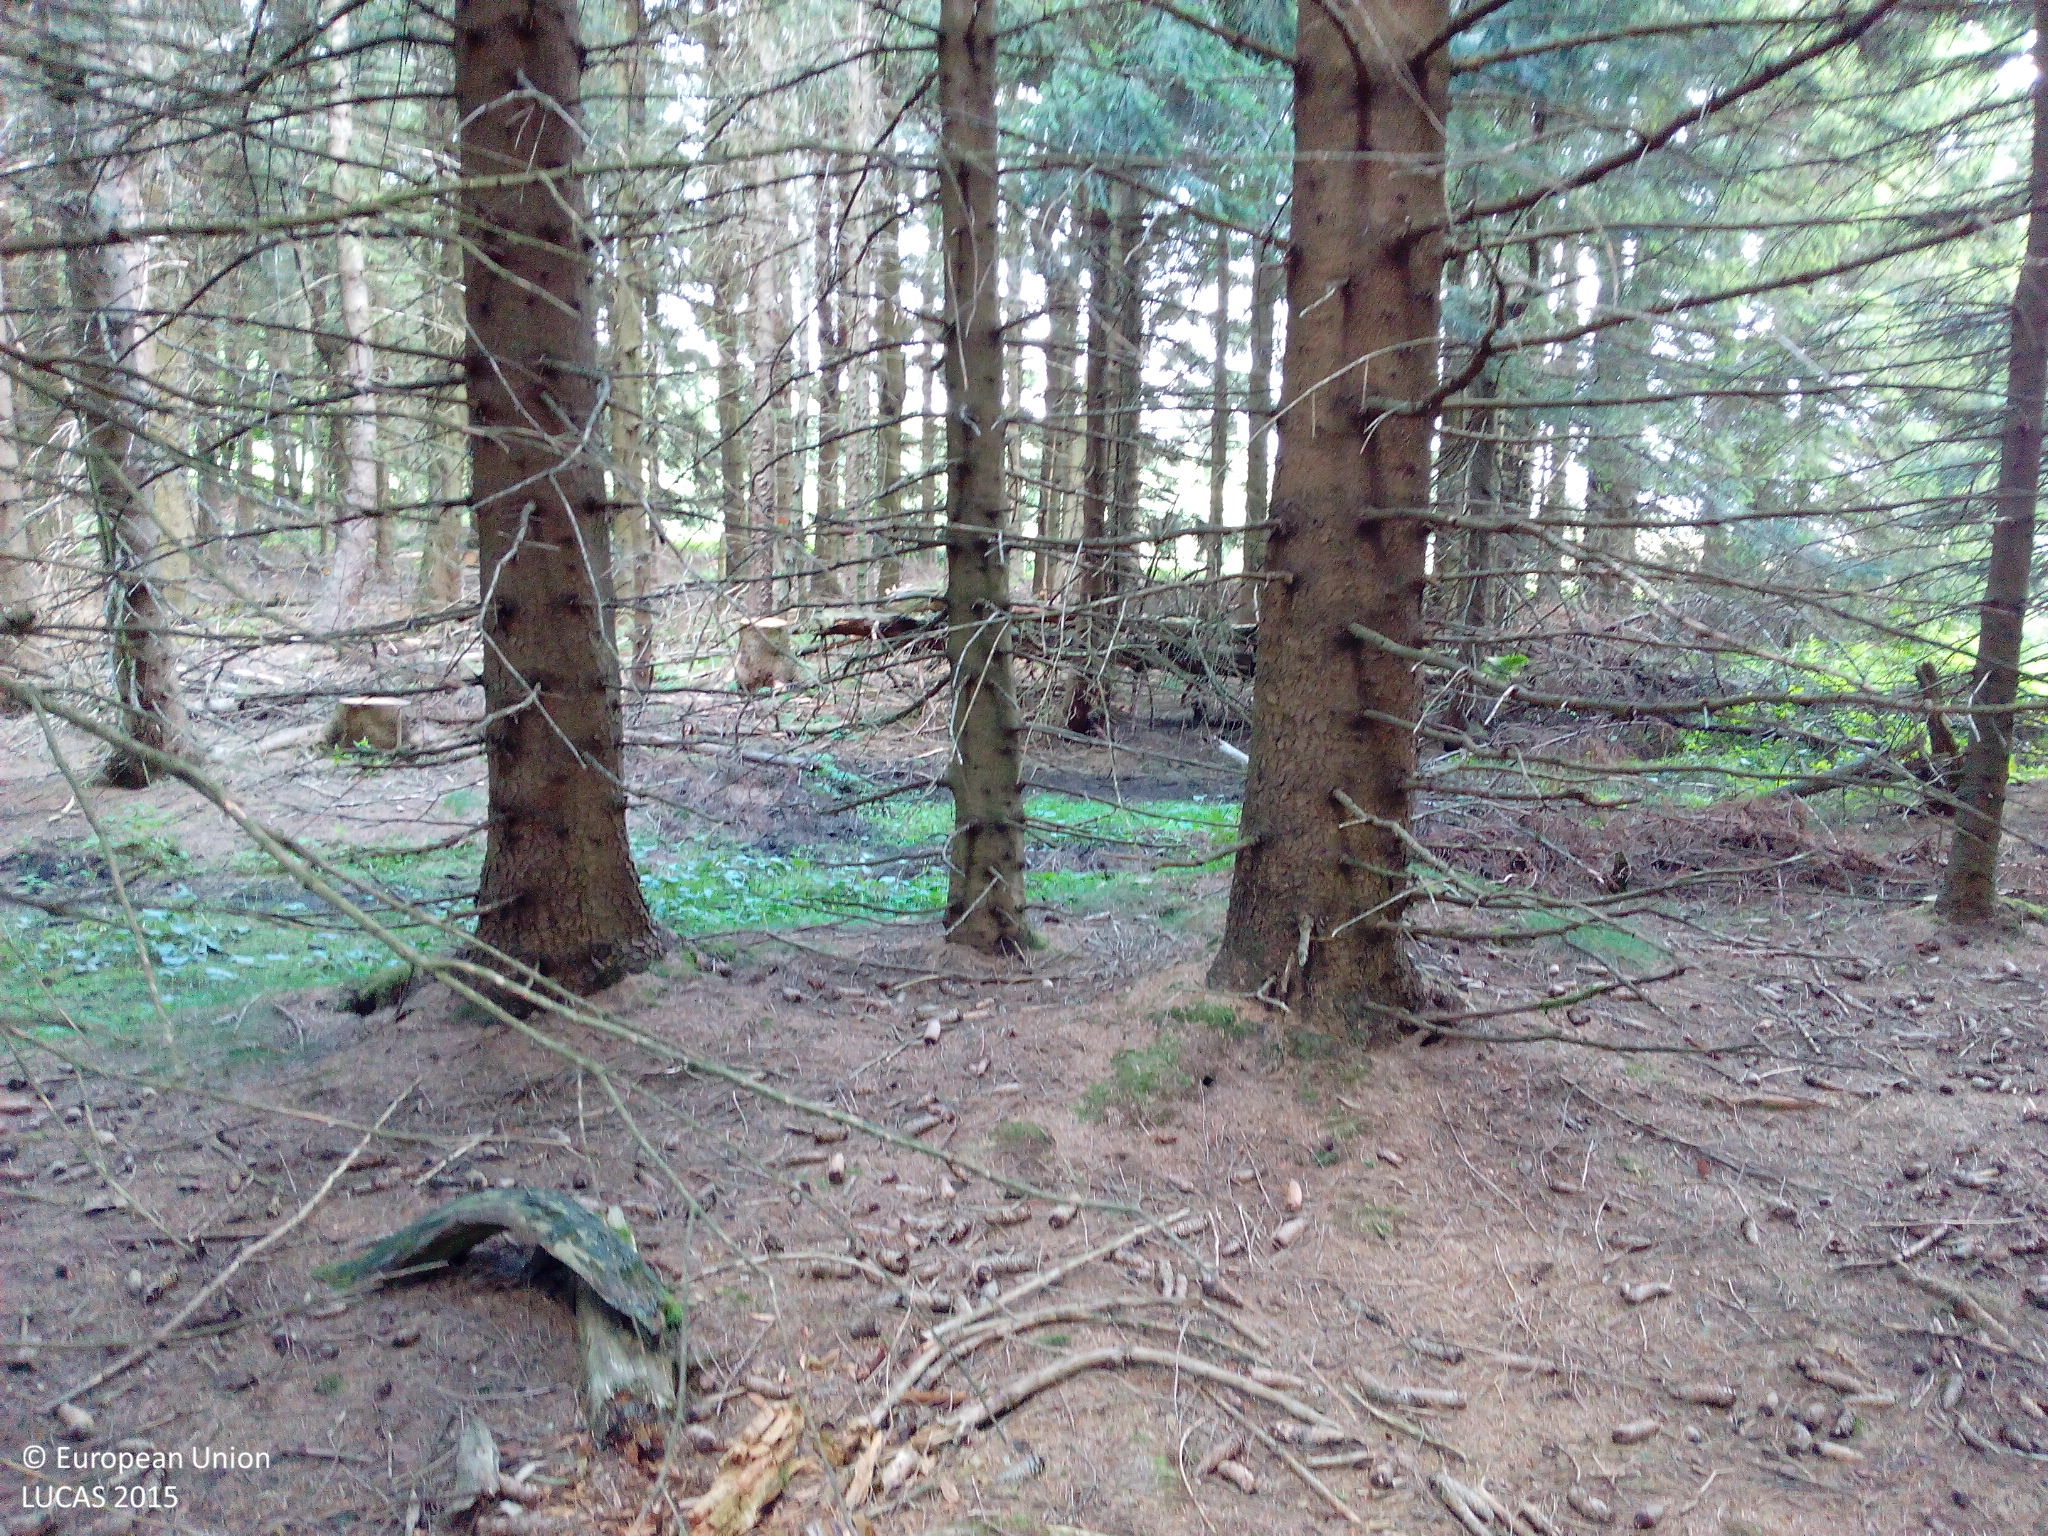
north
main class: Woodland
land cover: Spruce dominated coniferous woodland
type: hemiboreal forest and nemoral coniferous forest and mixed broadleaved-coniferous forest
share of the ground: > 75 %
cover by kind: coniferous forest trees 95 %, herbaceous plants 5 %
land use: Forestry
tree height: > 5 m
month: July
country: DE
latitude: 50.4899
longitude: 9.9577
